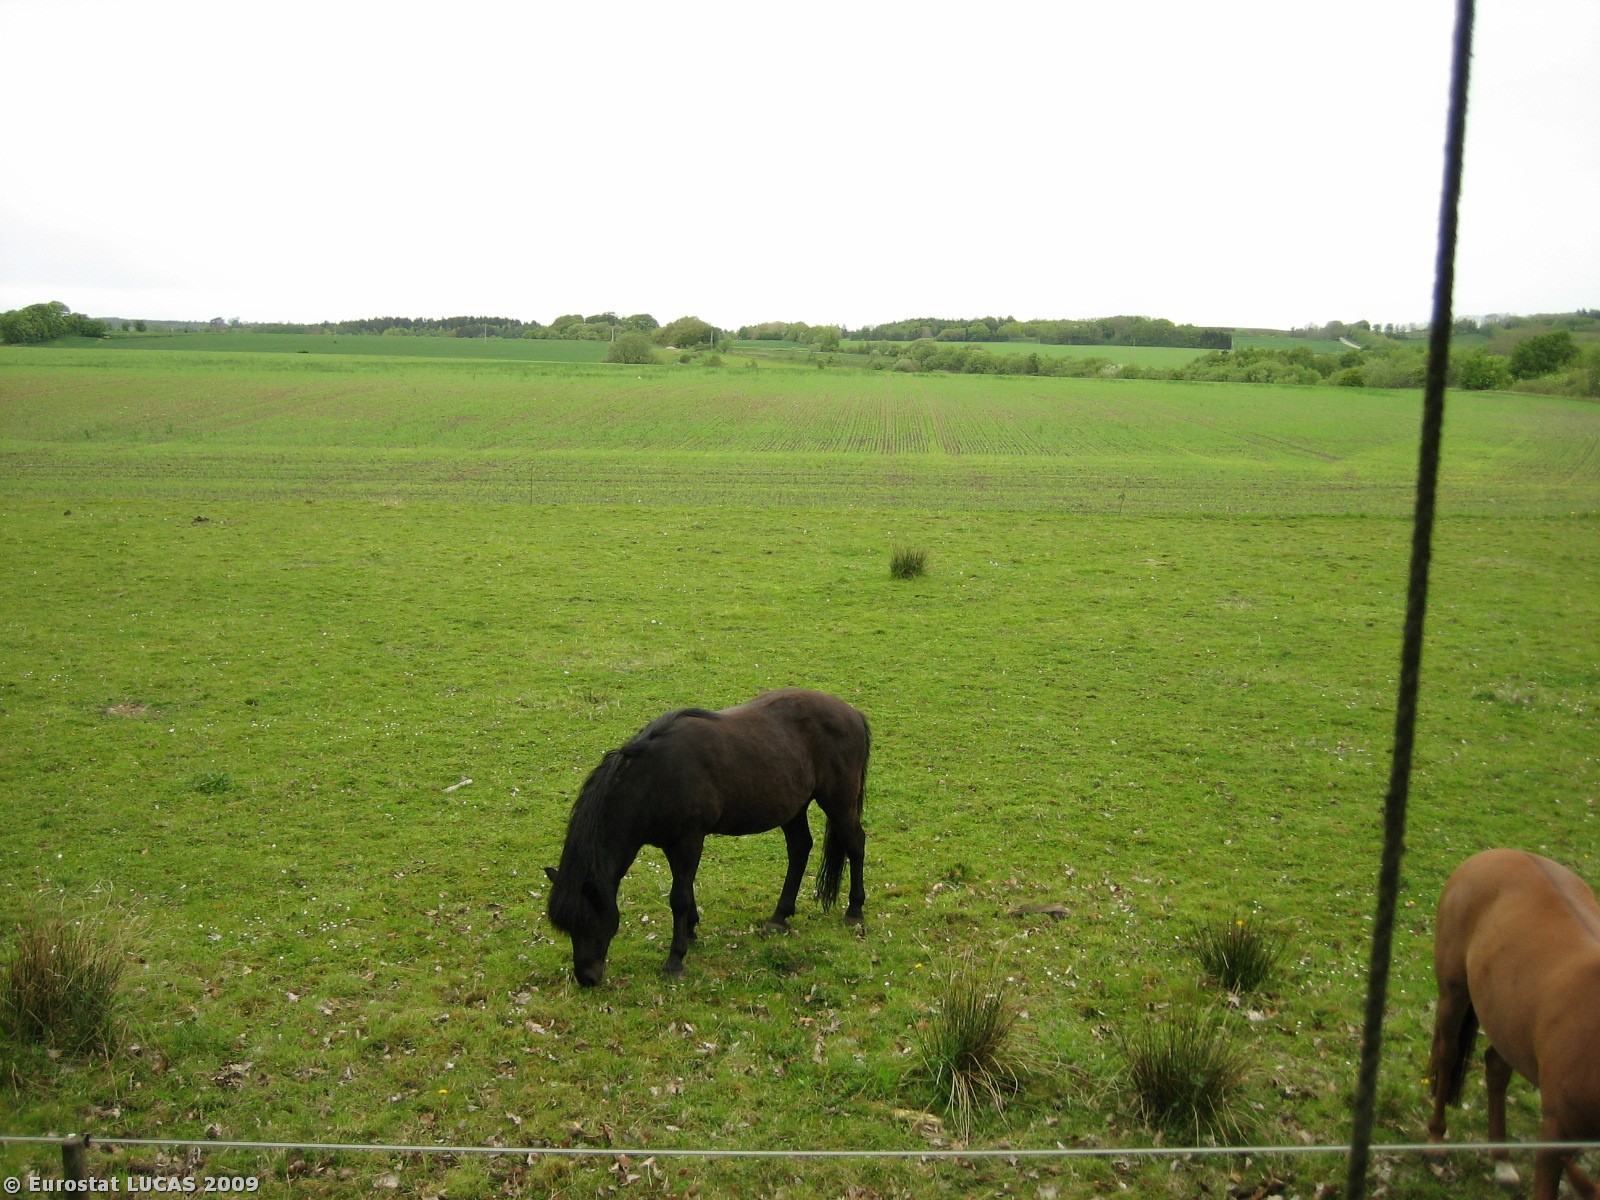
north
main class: Woodland
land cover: Broadleaved woodland
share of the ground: 50 - 75 %
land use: Unused
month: May
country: DK
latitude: 56.1794
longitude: 8.5357
